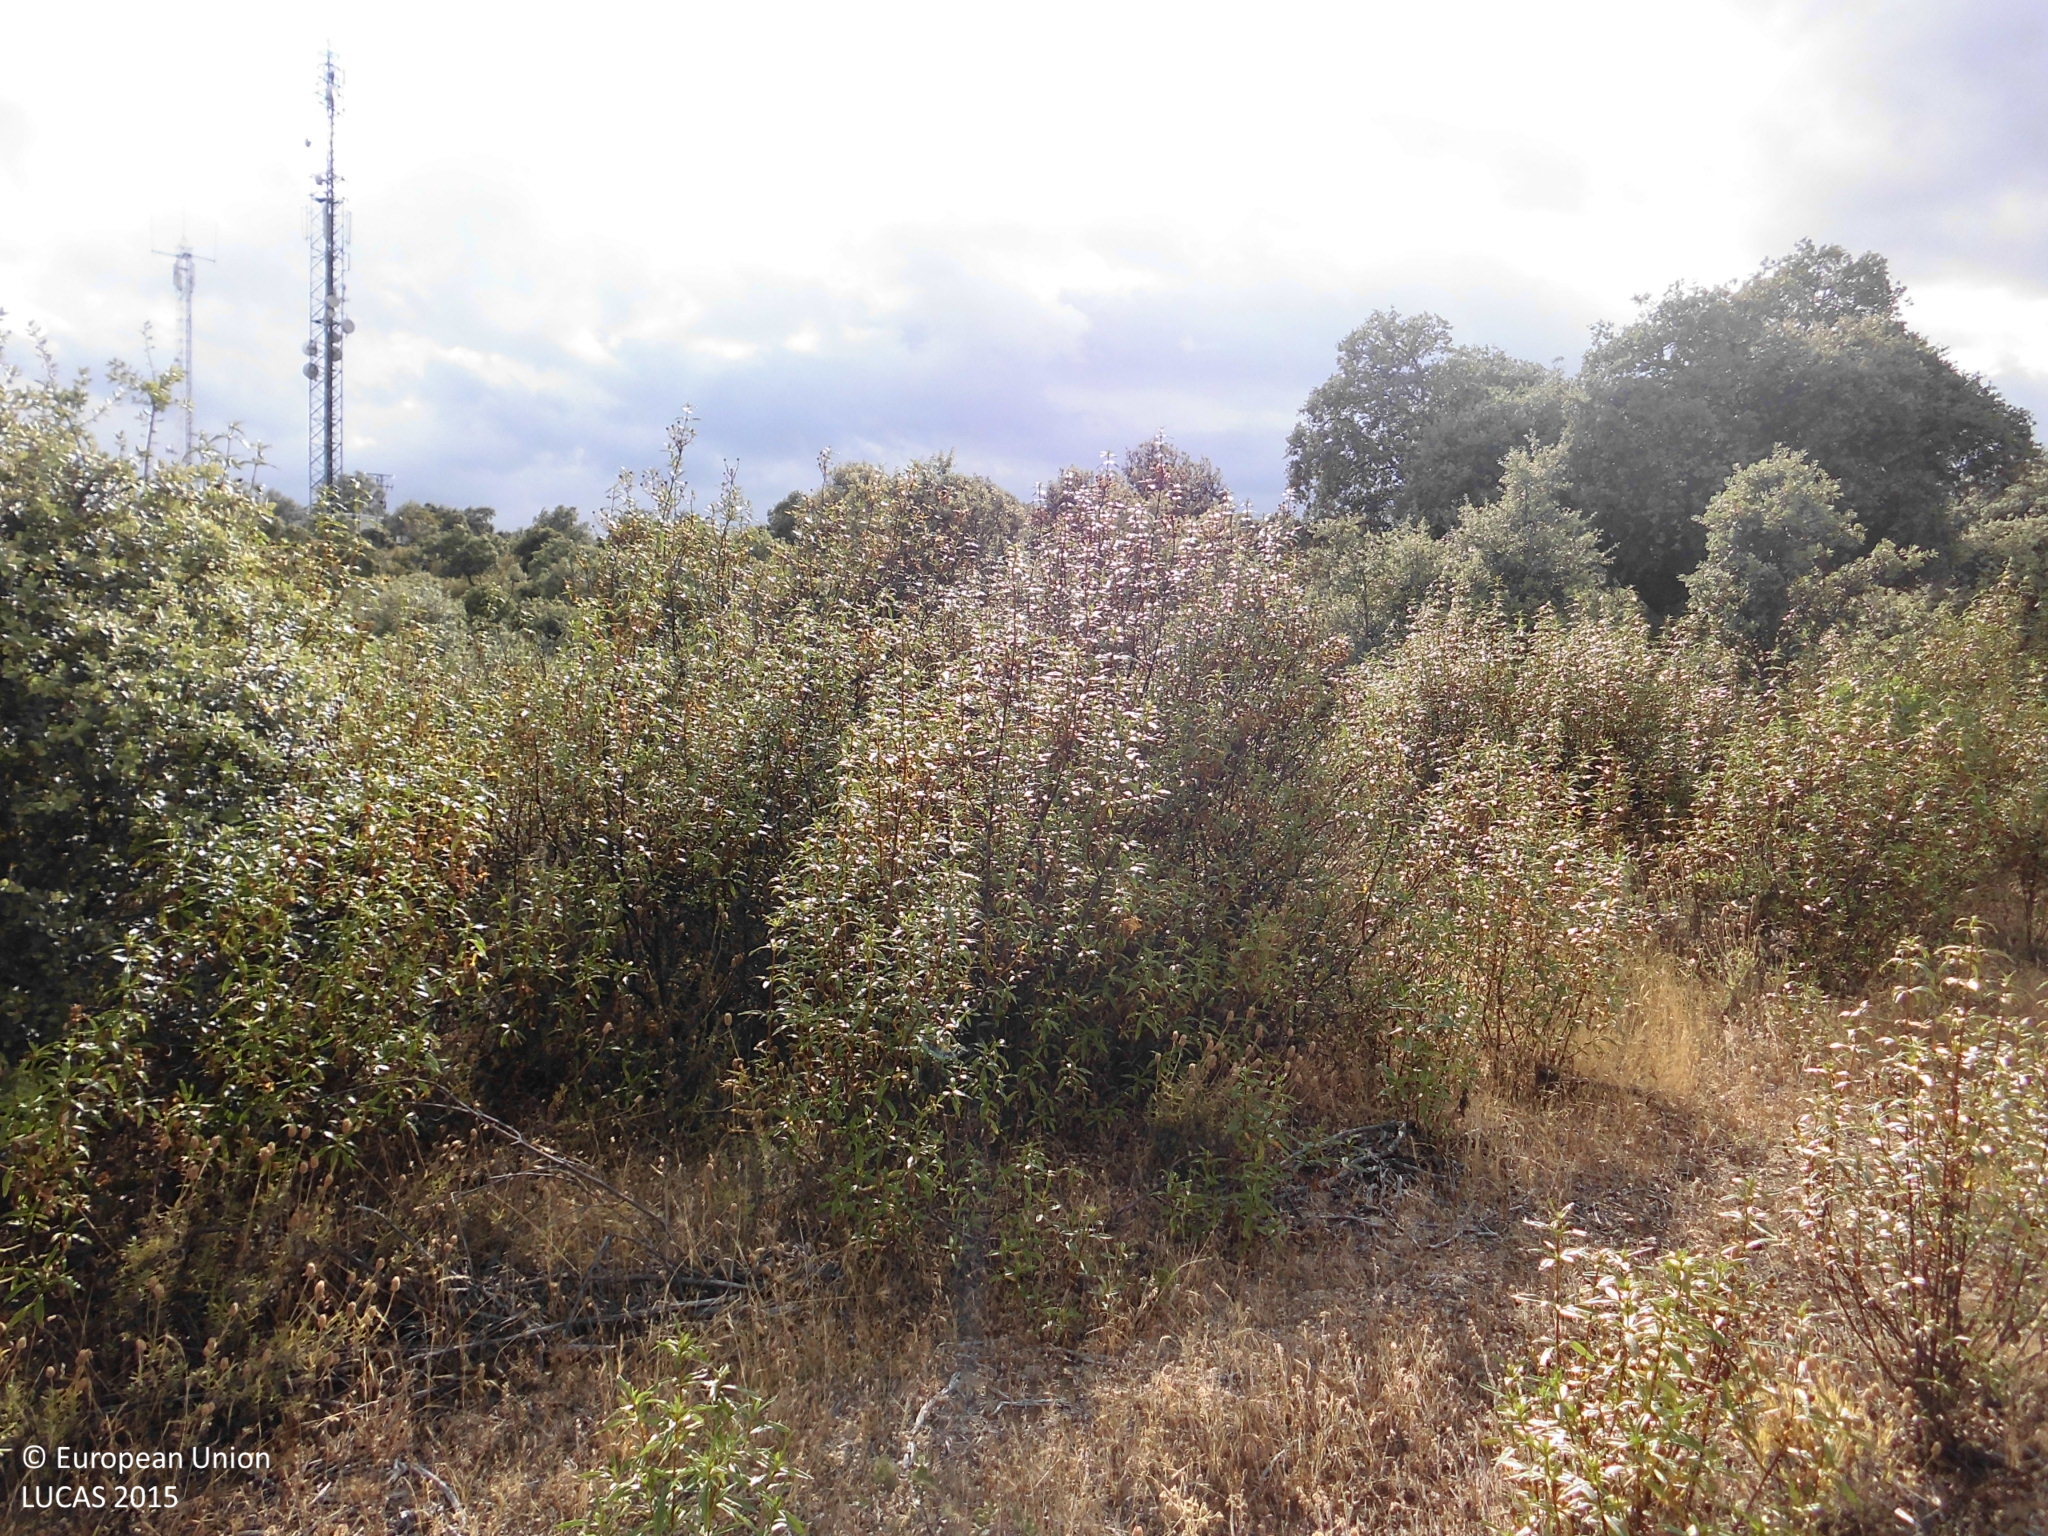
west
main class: Shrubland
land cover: Shrubland with sparse tree cover
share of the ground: 50 - 75 %
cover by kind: shrubs 60 %, herbaceous plants 30 %, broadleaved forest trees 5 %, consolidated bare surface 5 %
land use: Semi-natural and natural areas not in use
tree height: < 5 m
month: June
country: ES
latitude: 39.3346
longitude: -5.8687
